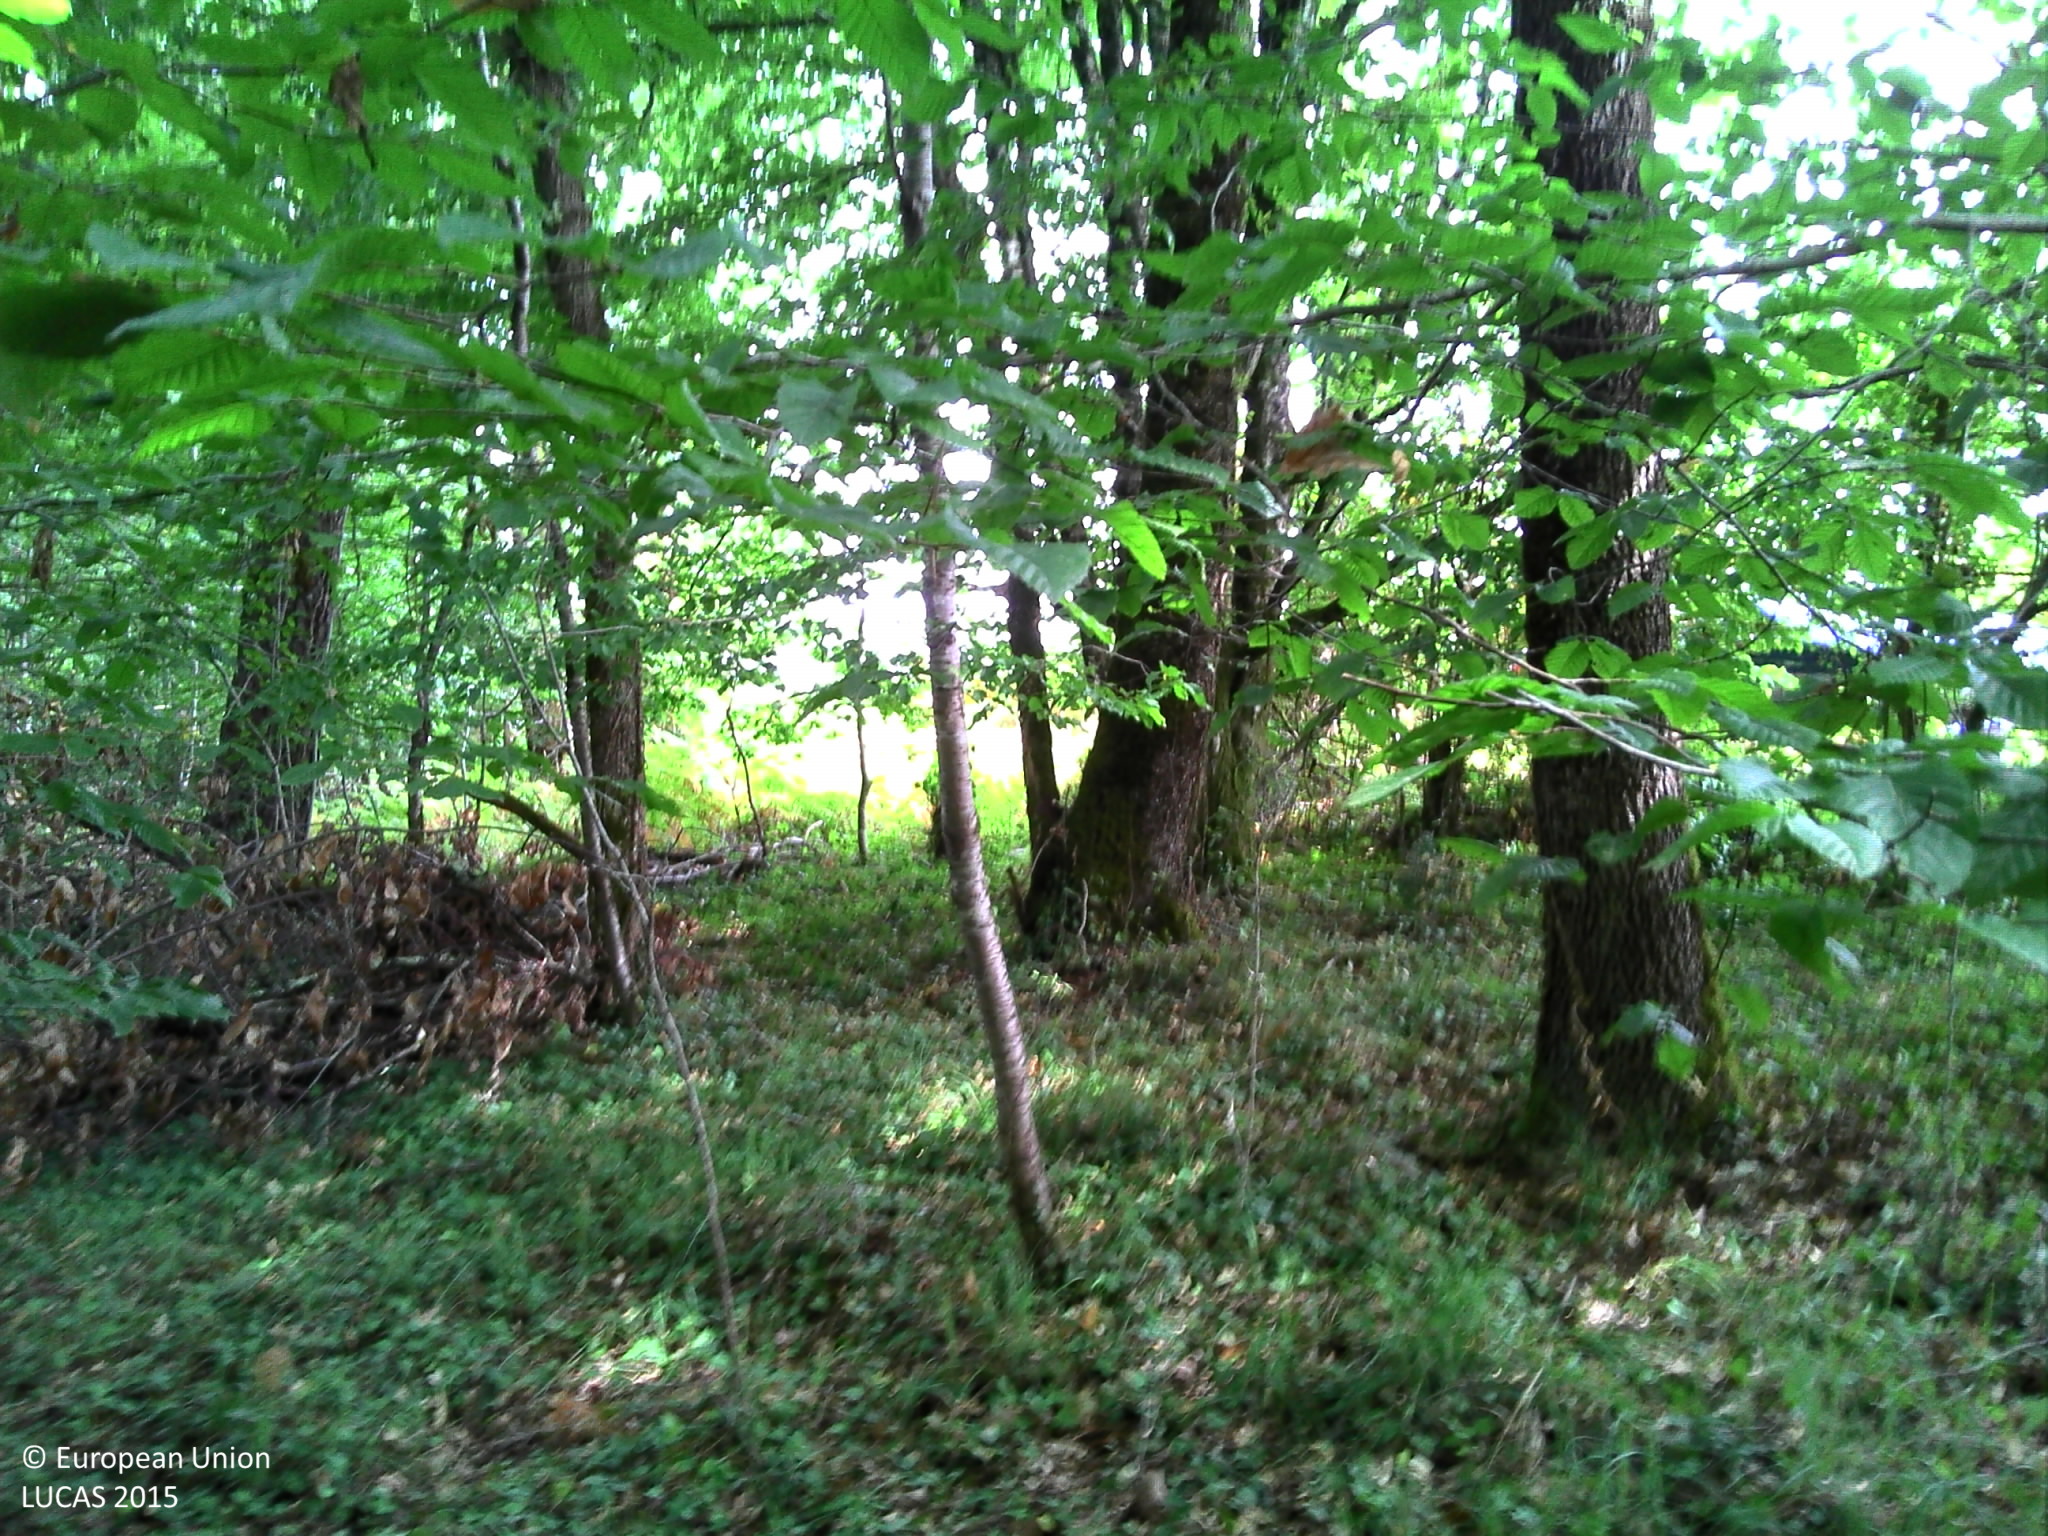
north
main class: Woodland
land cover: Broadleaved woodland
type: thermophilous deciduous forest
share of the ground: > 75 %
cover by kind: broadleaved forest trees 80 %, herbaceous plants 10 %, shrubs 5 %, lichens and mosses 5 %
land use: Forestry
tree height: > 5 m
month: July
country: FR
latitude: 44.9056
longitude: 0.8355
